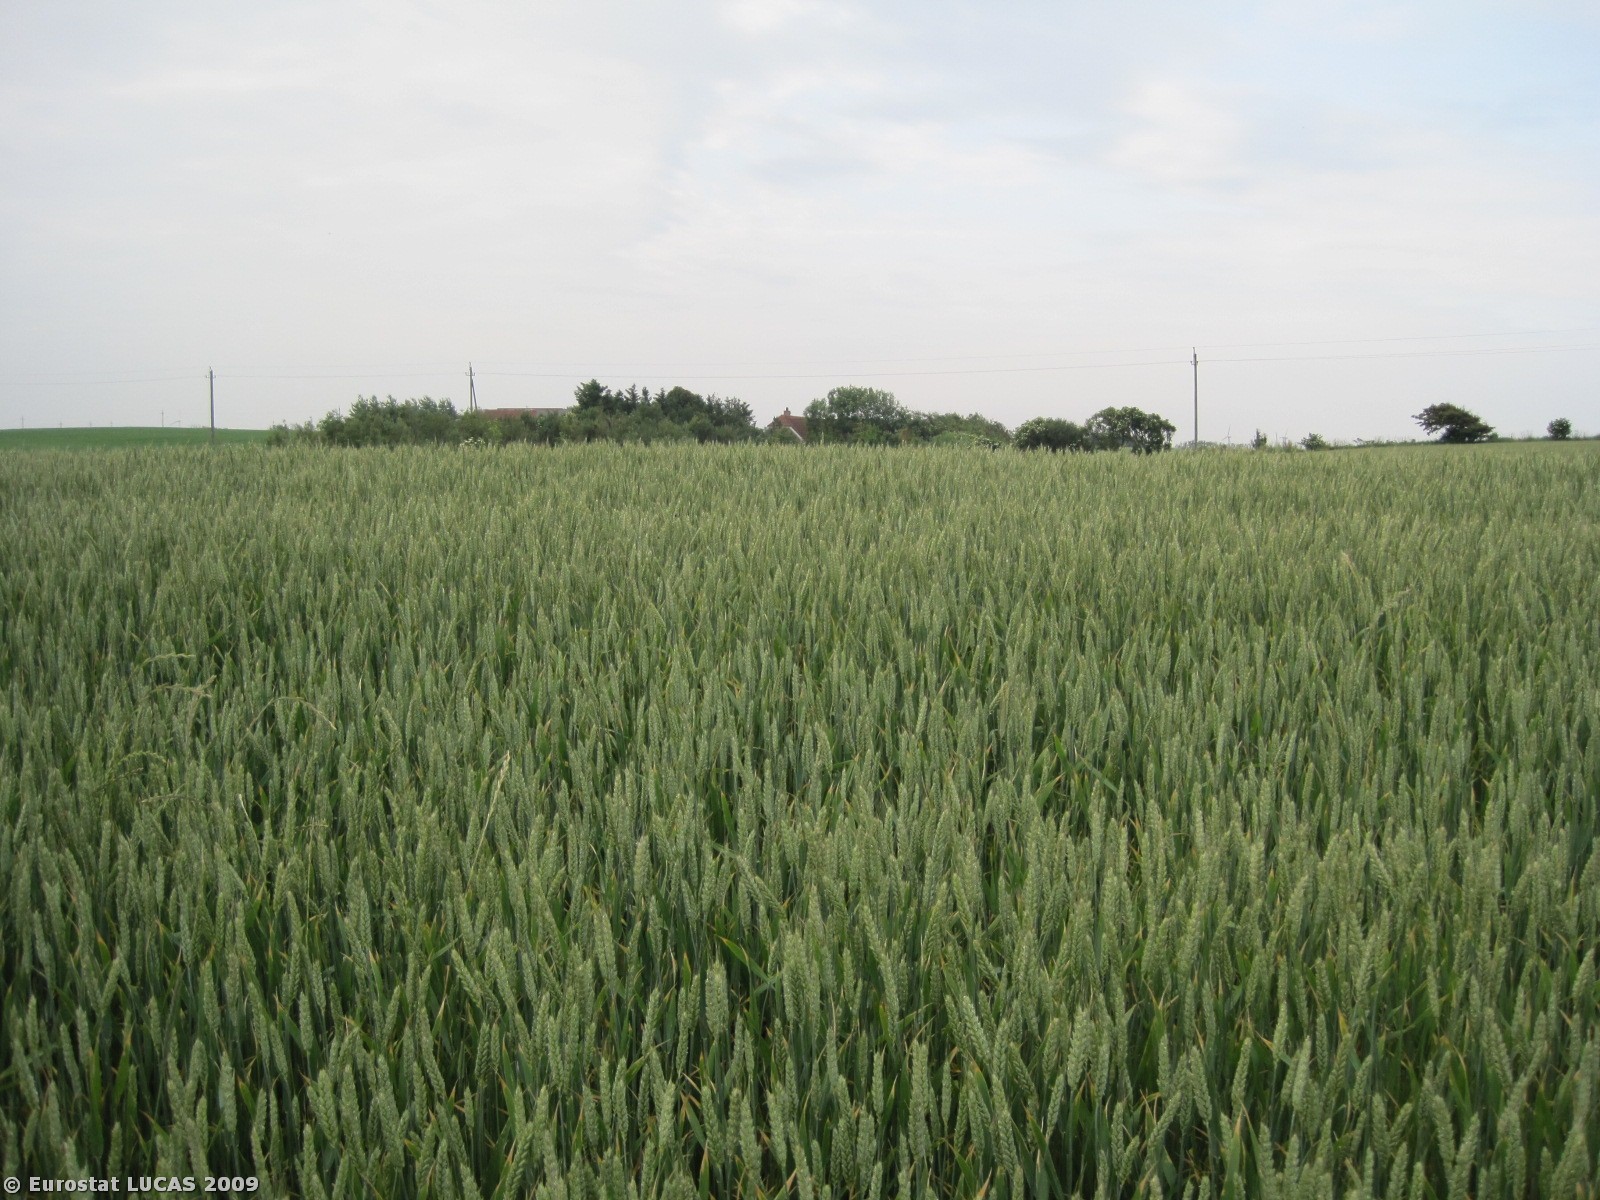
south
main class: Cropland
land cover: Common wheat
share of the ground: > 75 %
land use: Agriculture (excluding fallow land and kitchen gardens)
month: June
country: DK
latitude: 56.5549
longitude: 8.3589
